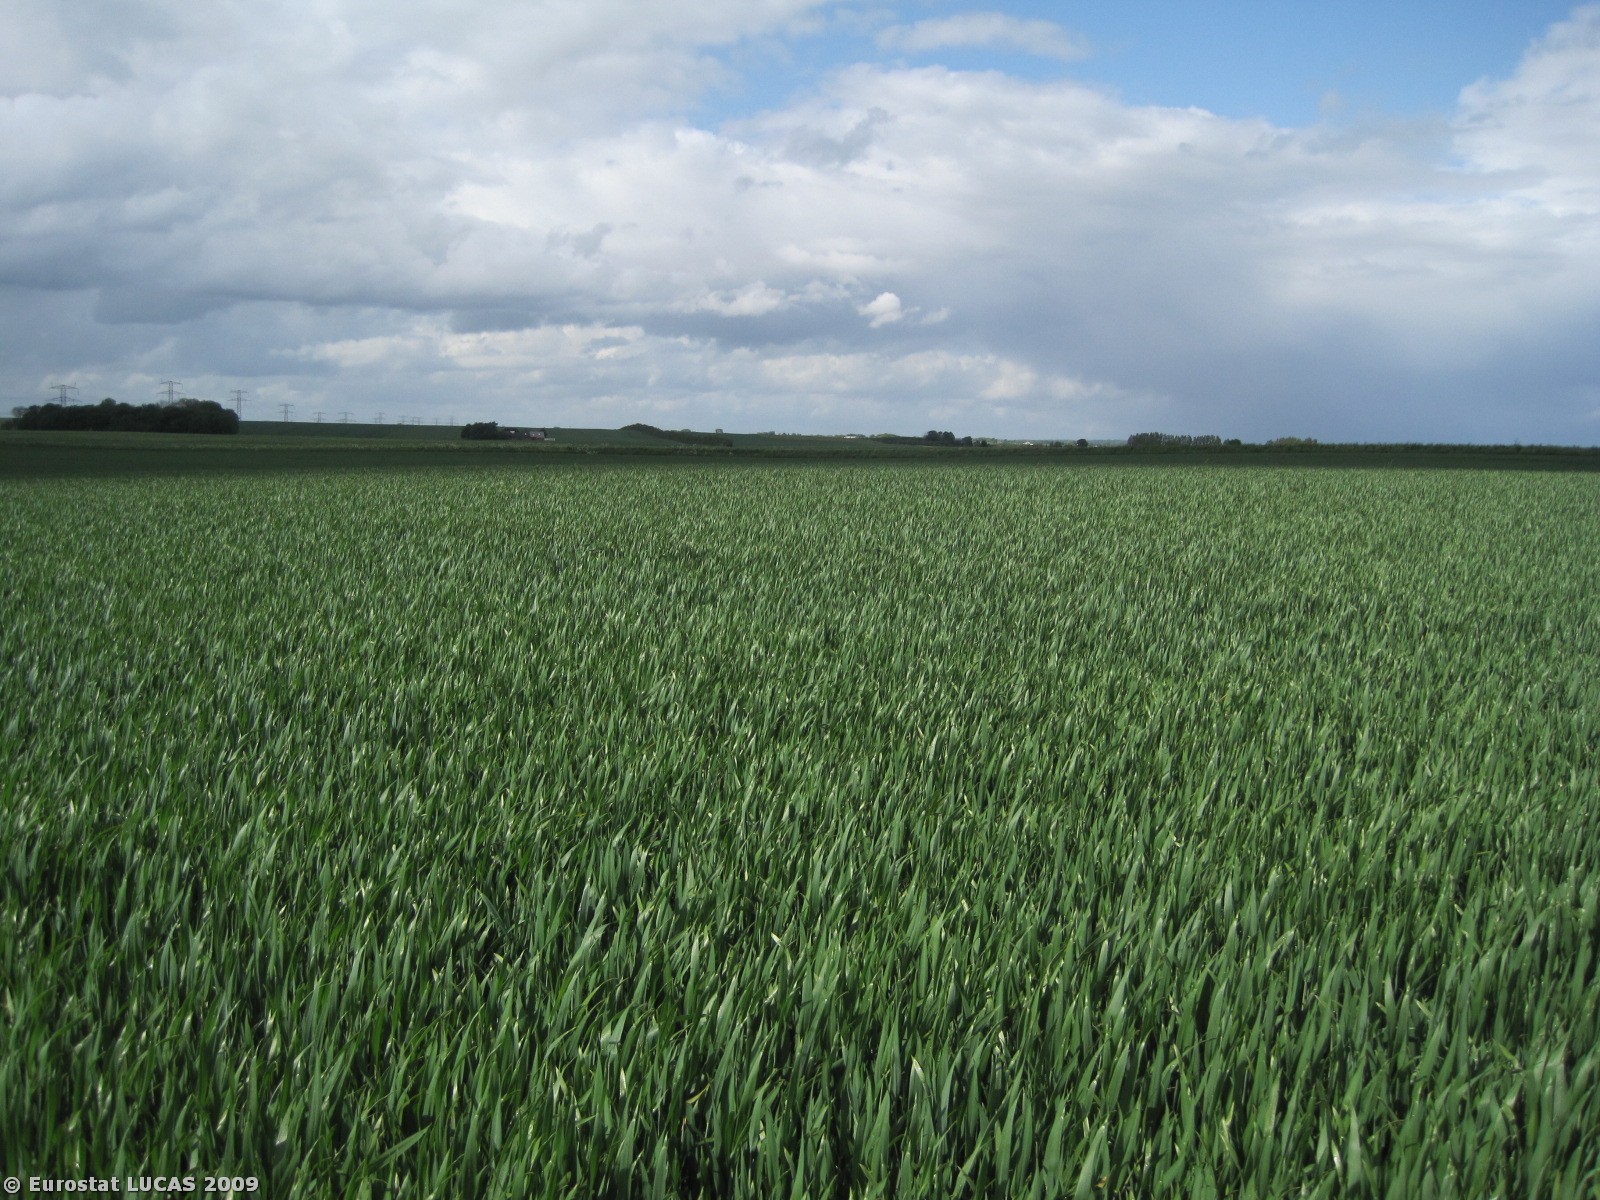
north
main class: Cropland
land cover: Common wheat
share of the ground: > 75 %
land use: Agriculture (excluding fallow land and kitchen gardens)
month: May
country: DK
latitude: 56.5113
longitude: 9.9838
